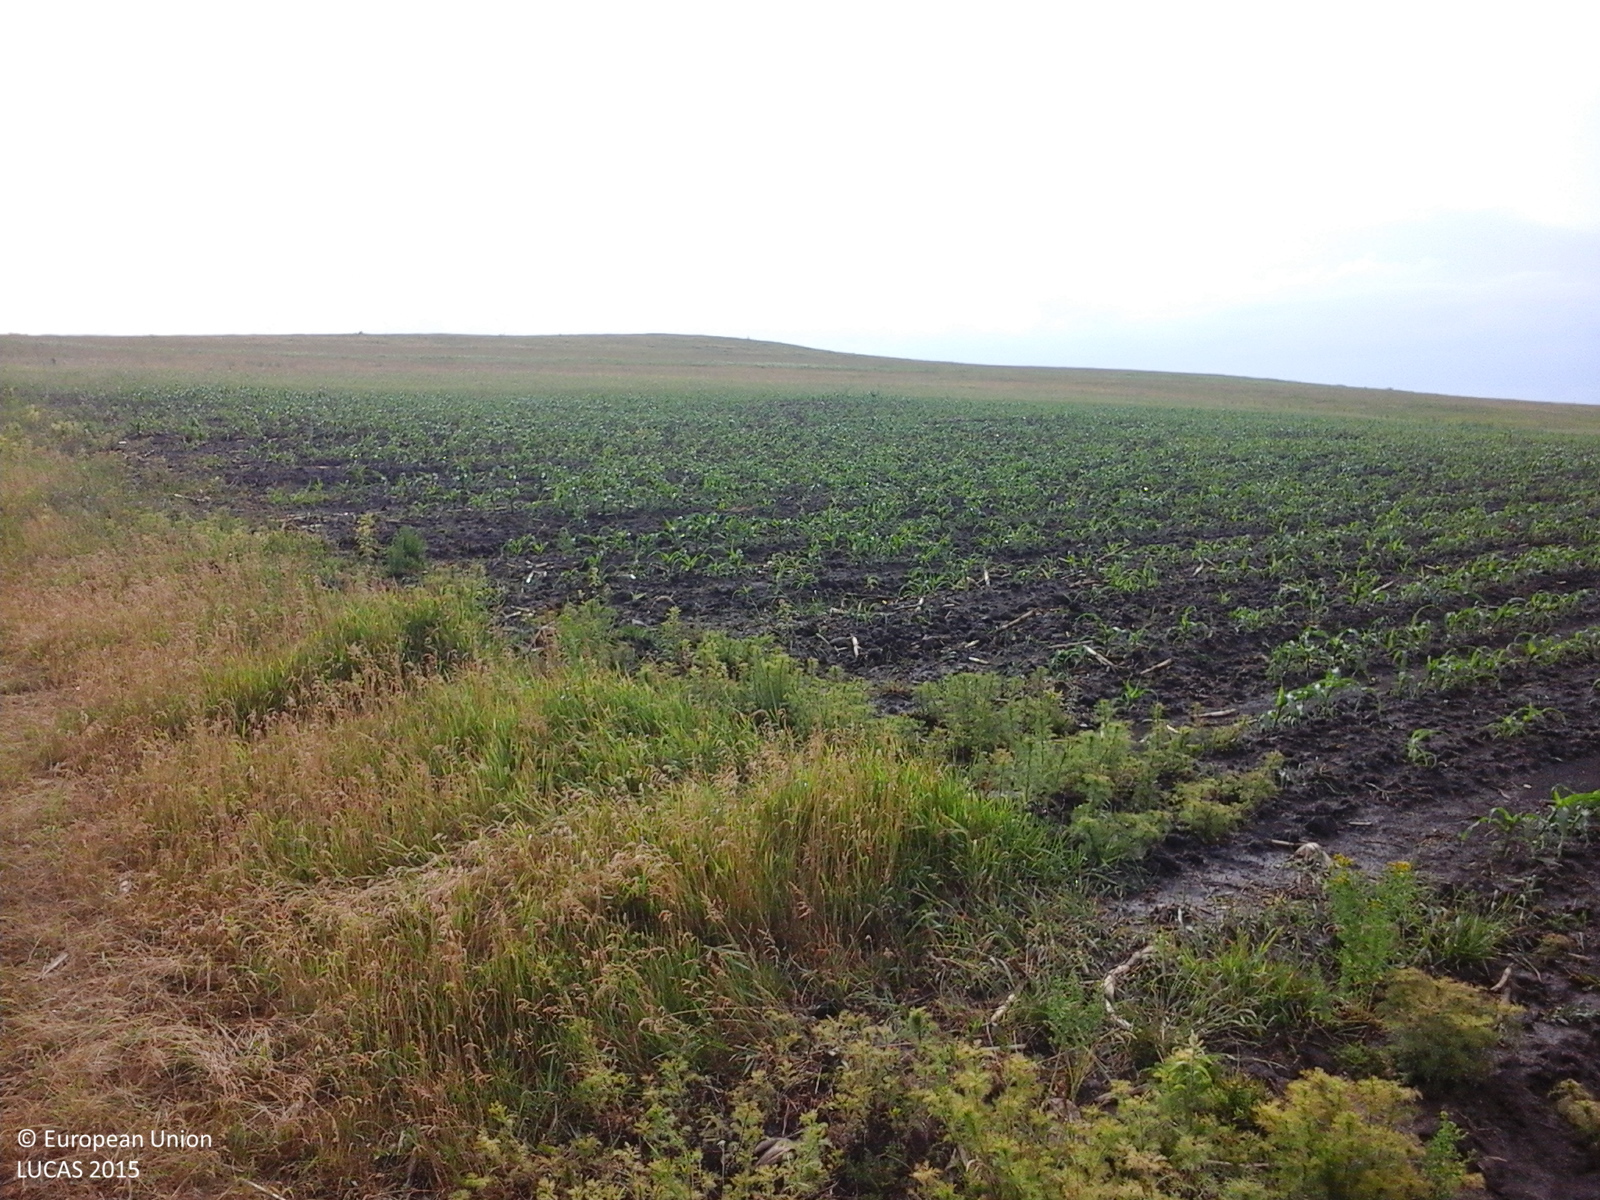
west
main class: Grassland
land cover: Grassland without tree/shrub cover
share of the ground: 25 - 50 %
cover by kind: herbaceous plants 100 %
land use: Agriculture (excluding fallow land and kitchen gardens)
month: June
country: RO
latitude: 47.3852
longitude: 26.4188
